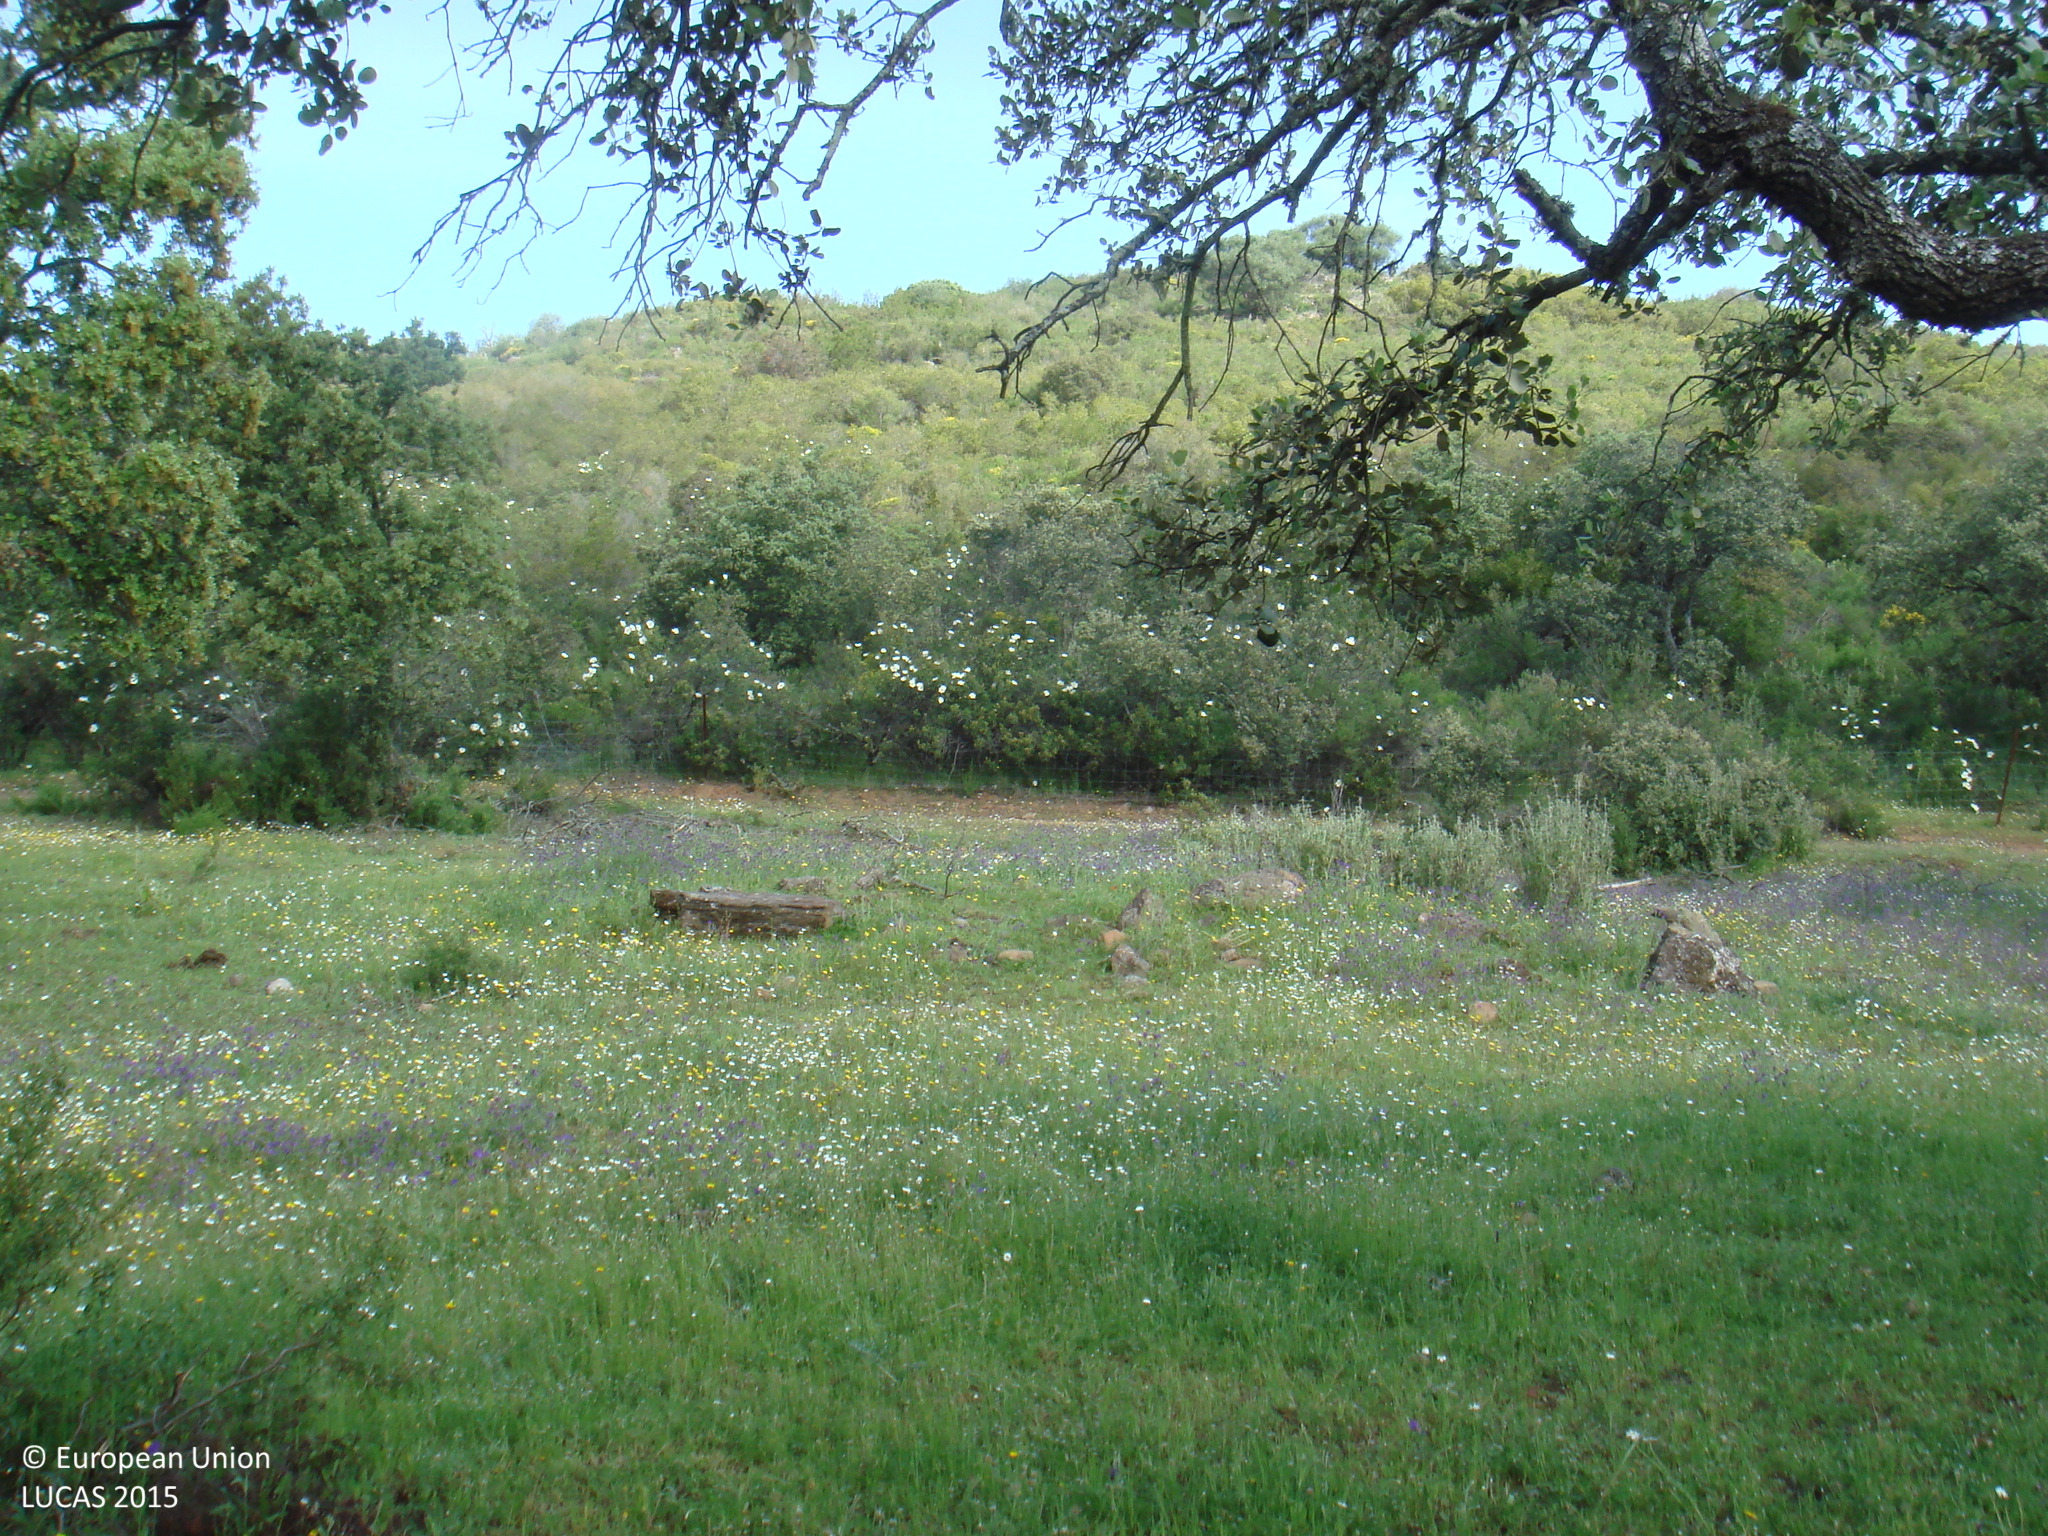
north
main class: Woodland
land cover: Broadleaved woodland
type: broadleaved evergreen forest
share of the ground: 25 - 50 %
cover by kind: herbaceous plants 60 %, broadleaved forest trees 30 %, shrubs 10 %
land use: Forestry
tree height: > 5 m
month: April
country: ES
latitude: 38.1929
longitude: -5.0842
